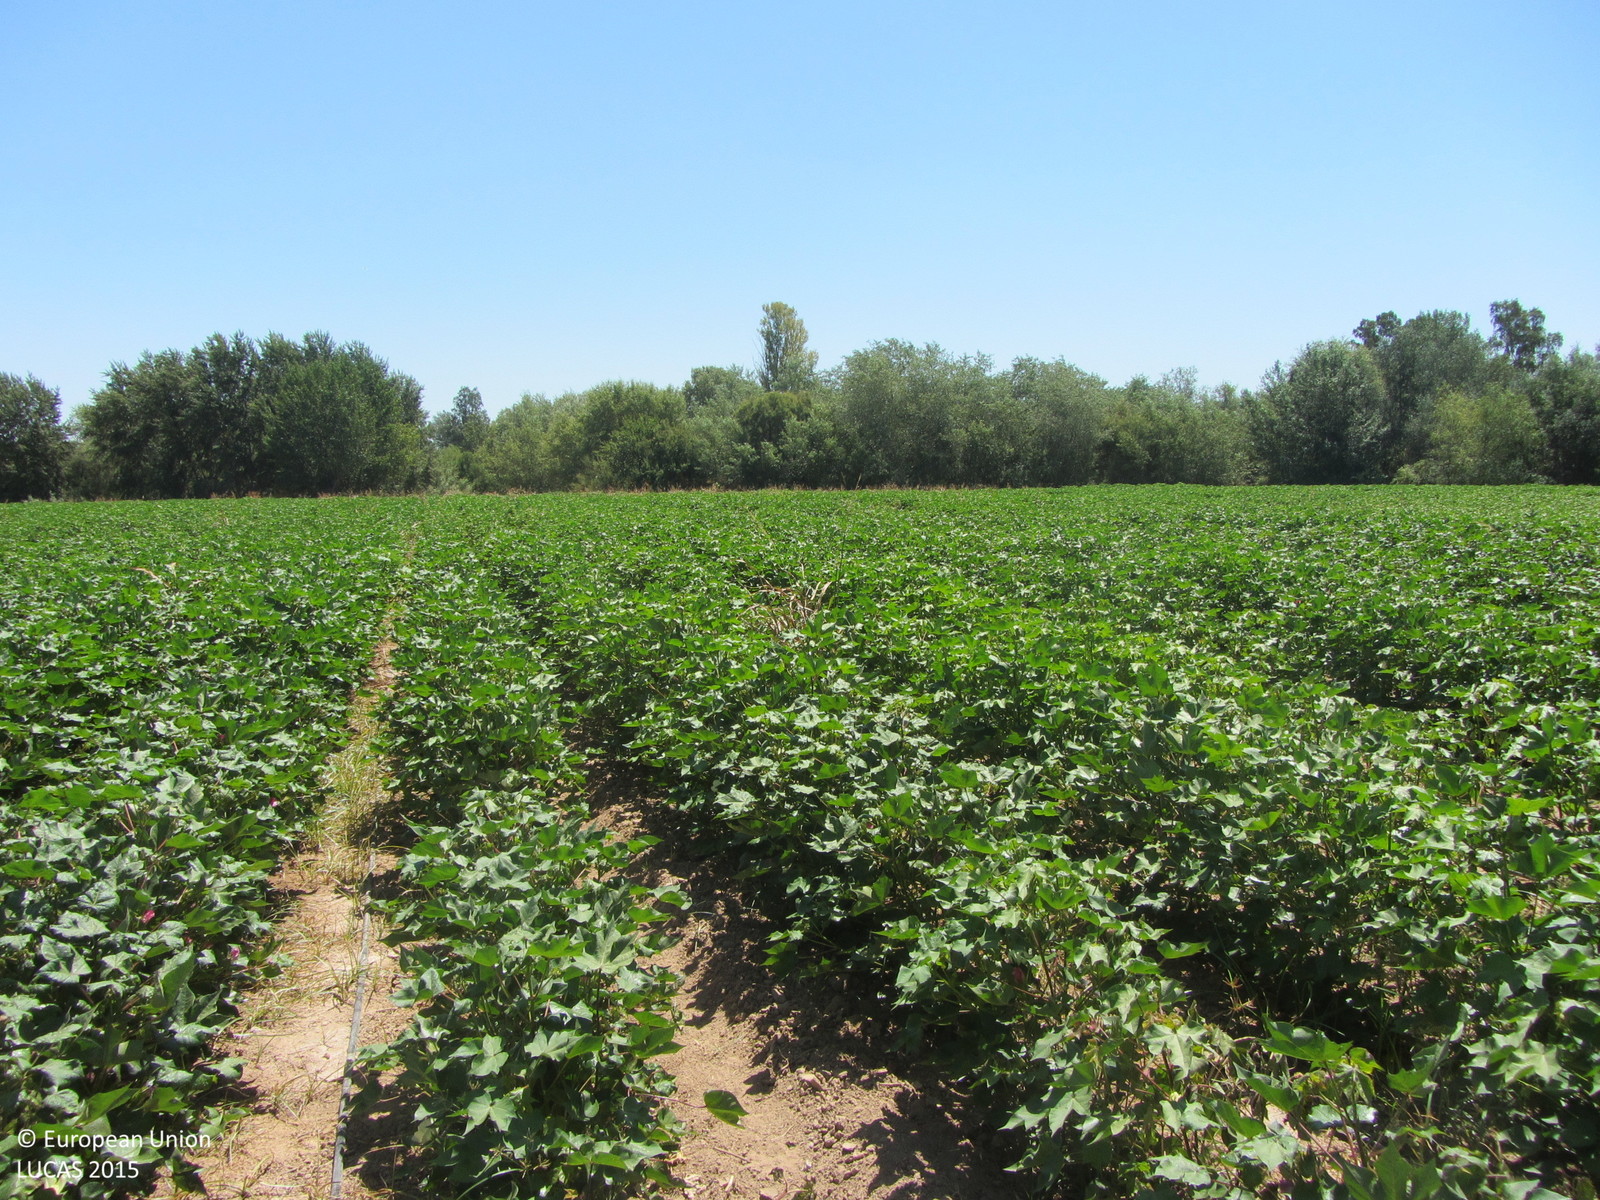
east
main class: Cropland
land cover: Cotton
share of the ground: > 75 %
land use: Agriculture (excluding fallow land and kitchen gardens)
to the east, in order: Cotton; Tracks; Broadleaved woodland; Grassland with sparse tree/shrub cover; Broadleaved woodland; Inland fresh running water; Broadleaved woodland; Tracks; Arable land (only in case pi)
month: July
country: ES
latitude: 38.0183
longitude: -3.8218
